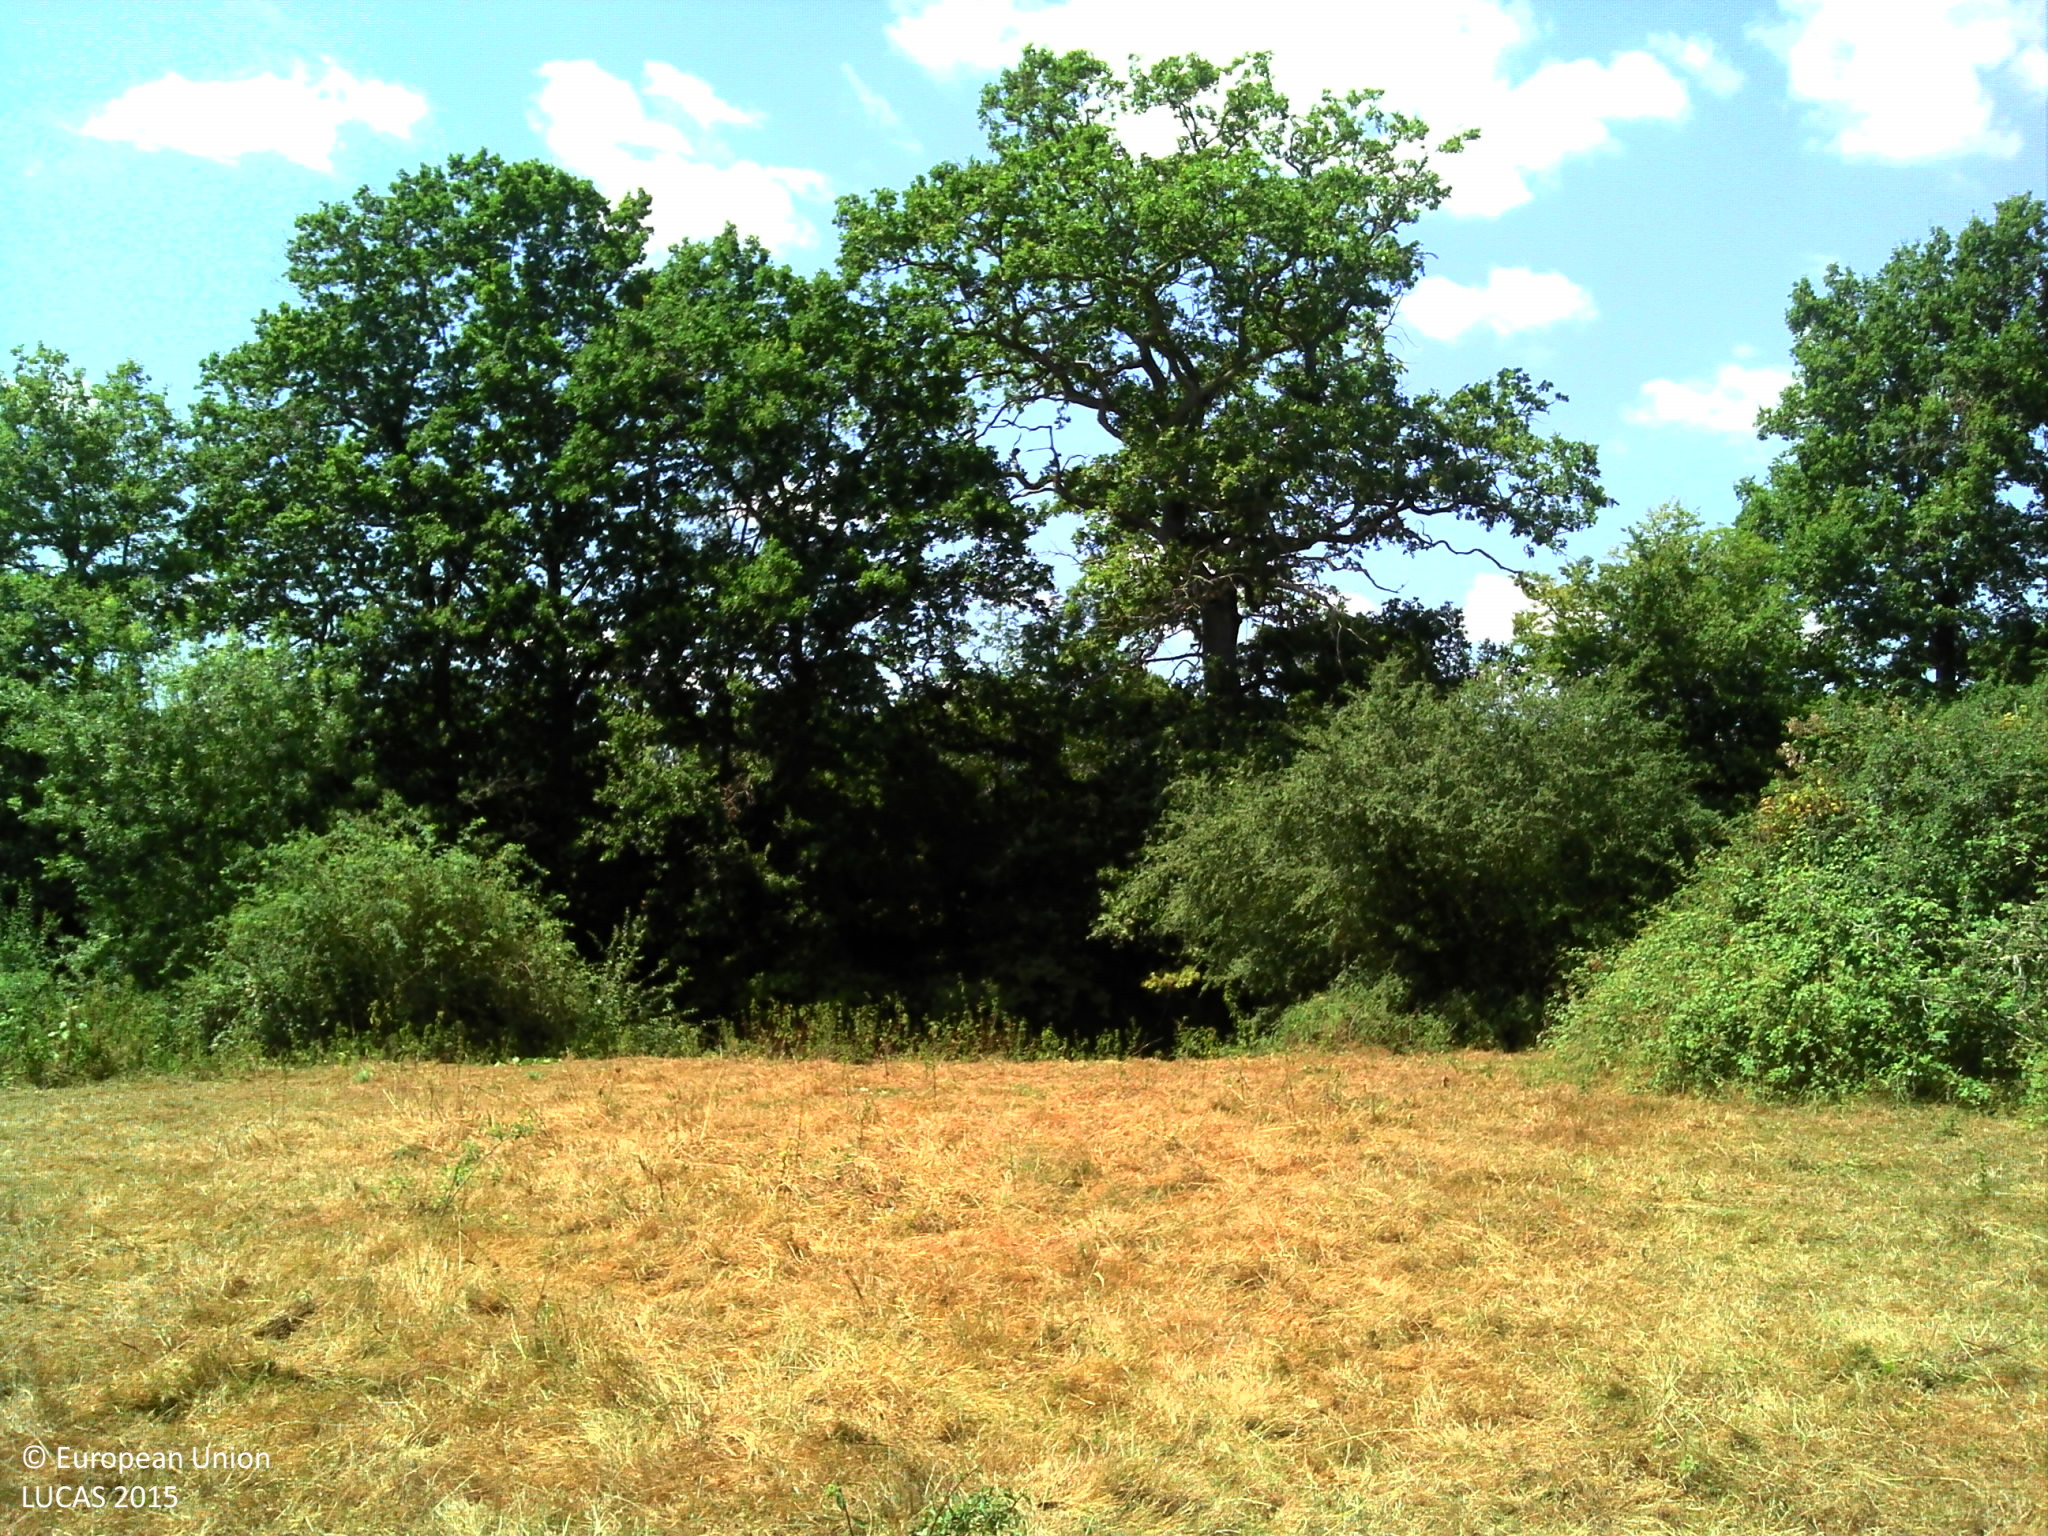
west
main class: Grassland
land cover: Grassland without tree/shrub cover
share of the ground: > 75 %
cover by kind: herbaceous plants 95 %, shrubs 5 %
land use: Agriculture (excluding fallow land and kitchen gardens)
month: July
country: FR
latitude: 46.8645
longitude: 3.6097
